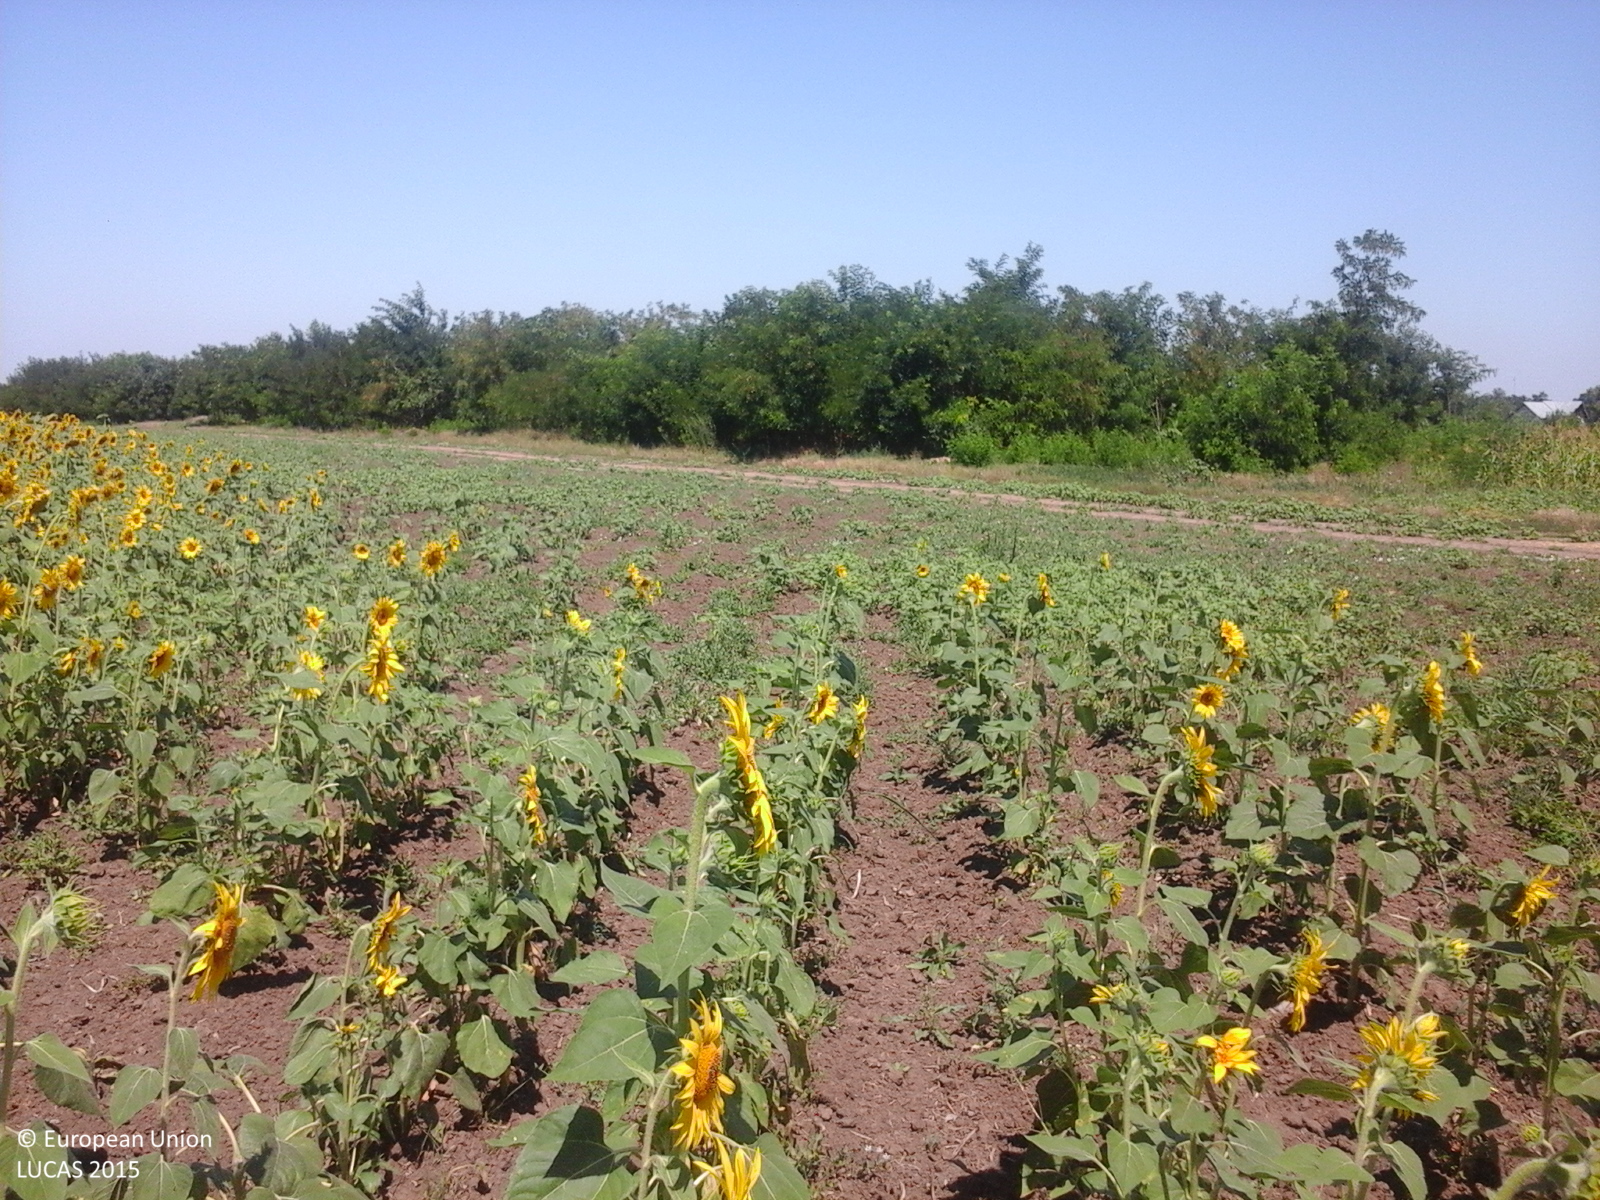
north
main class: Cropland
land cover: Sunflower
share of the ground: > 75 %
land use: Agriculture (excluding fallow land and kitchen gardens)
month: July
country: RO
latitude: 44.2546
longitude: 26.5850
